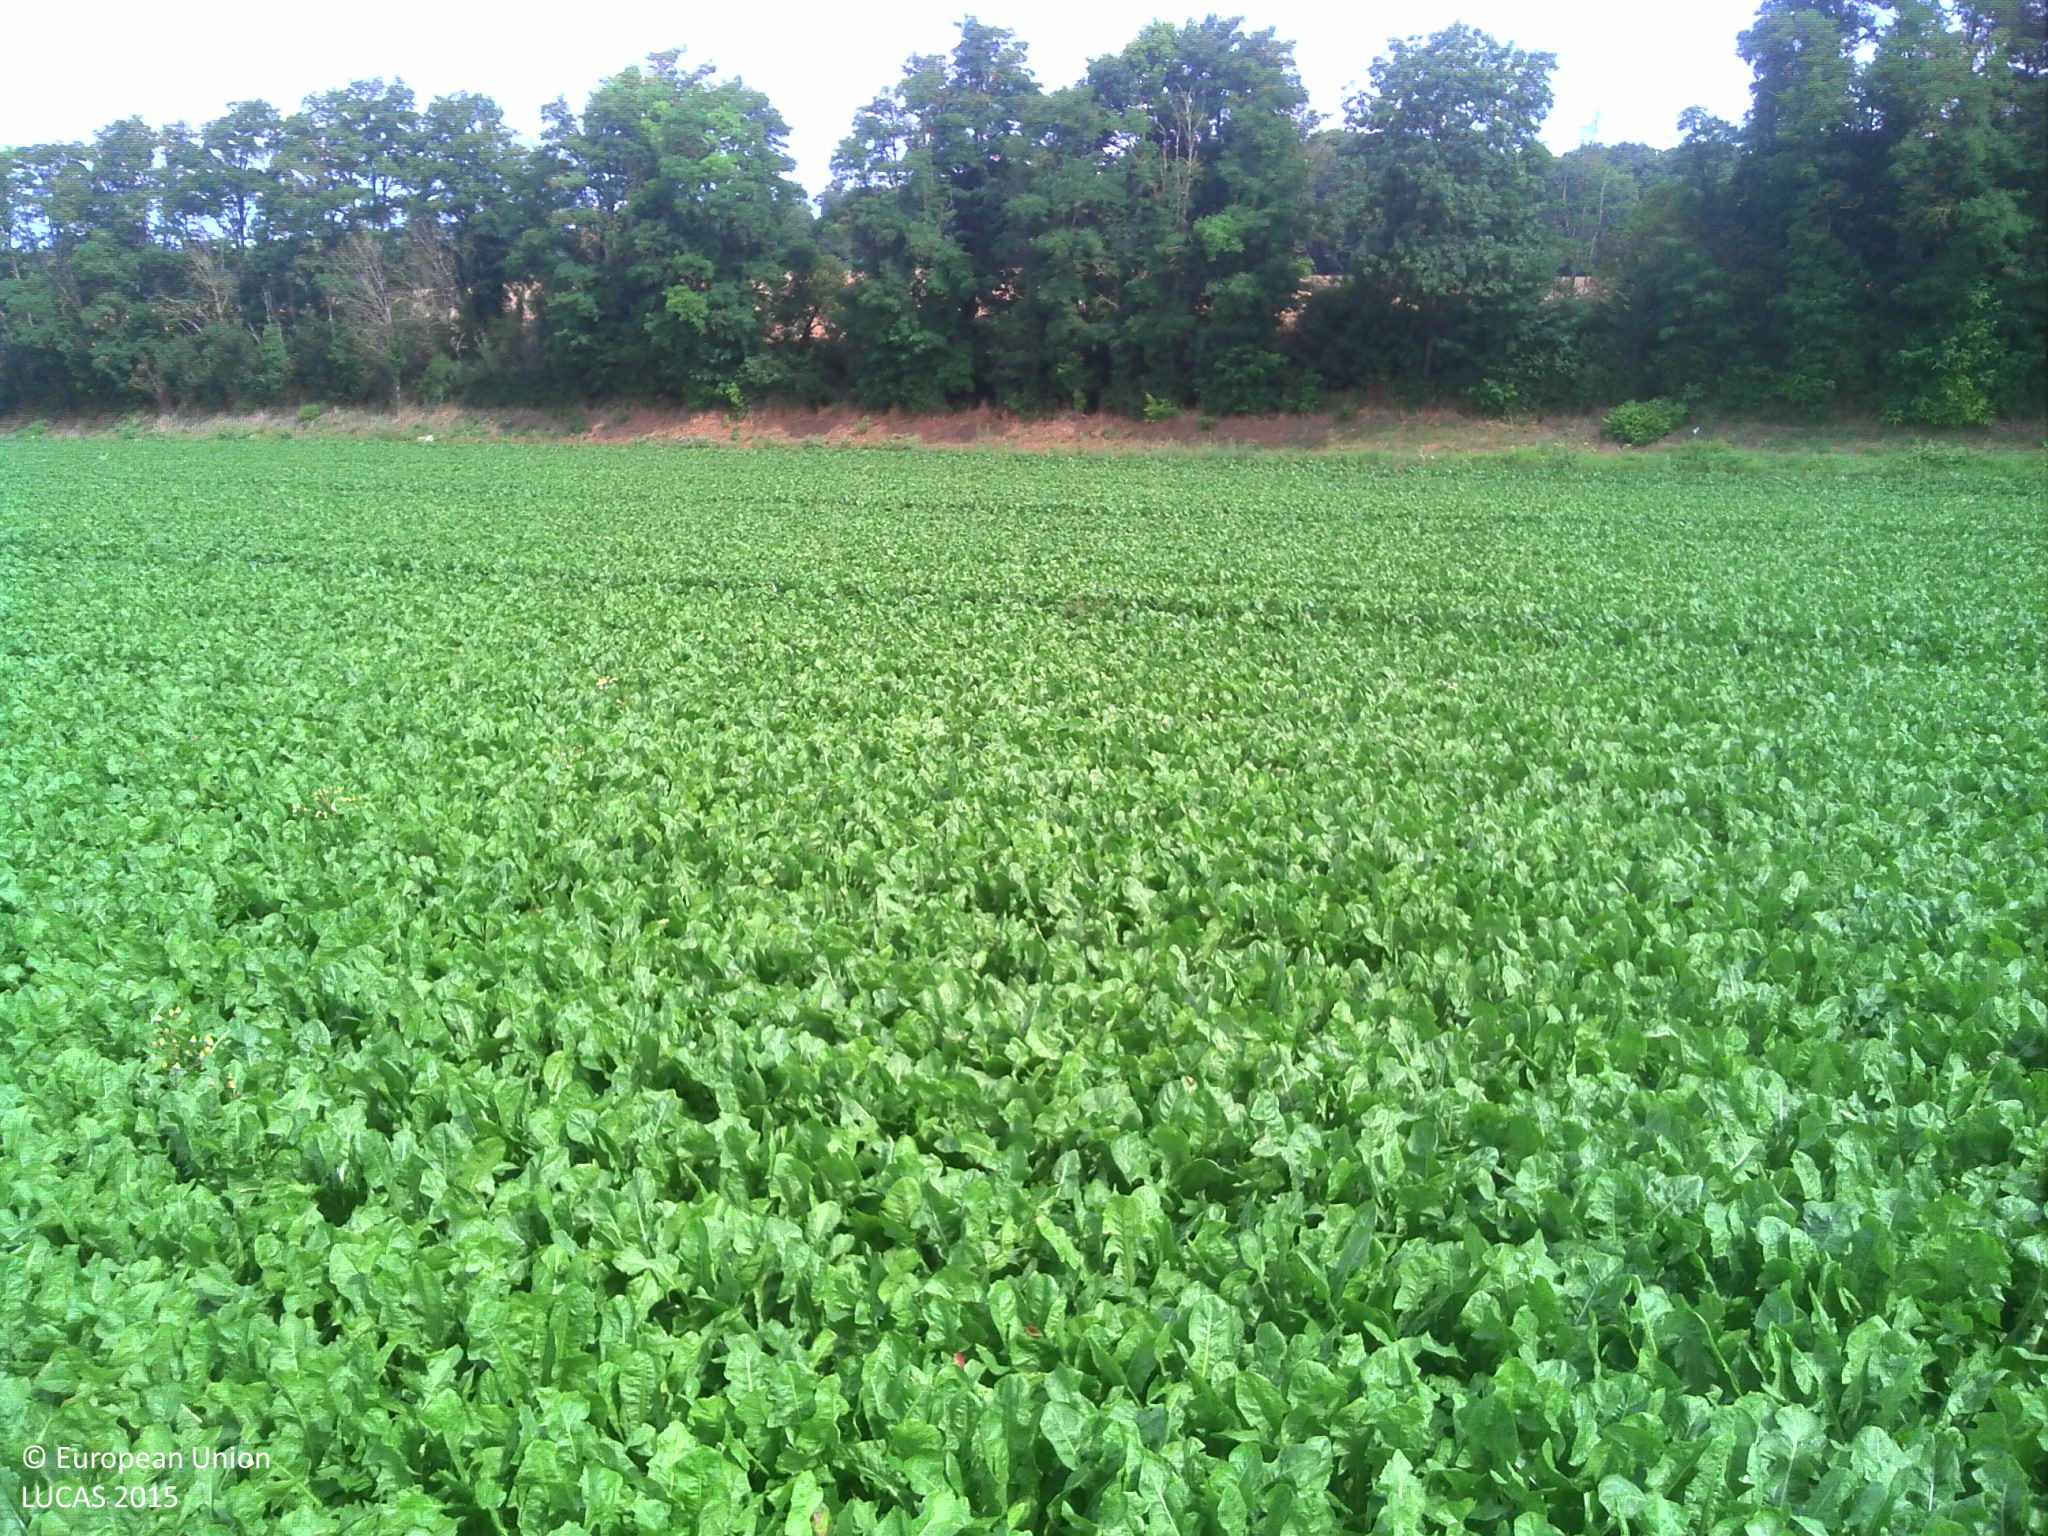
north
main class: Cropland
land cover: Sugar beet
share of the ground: > 75 %
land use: Agriculture (excluding fallow land and kitchen gardens)
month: July
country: FR
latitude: 49.6978
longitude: 3.6017
